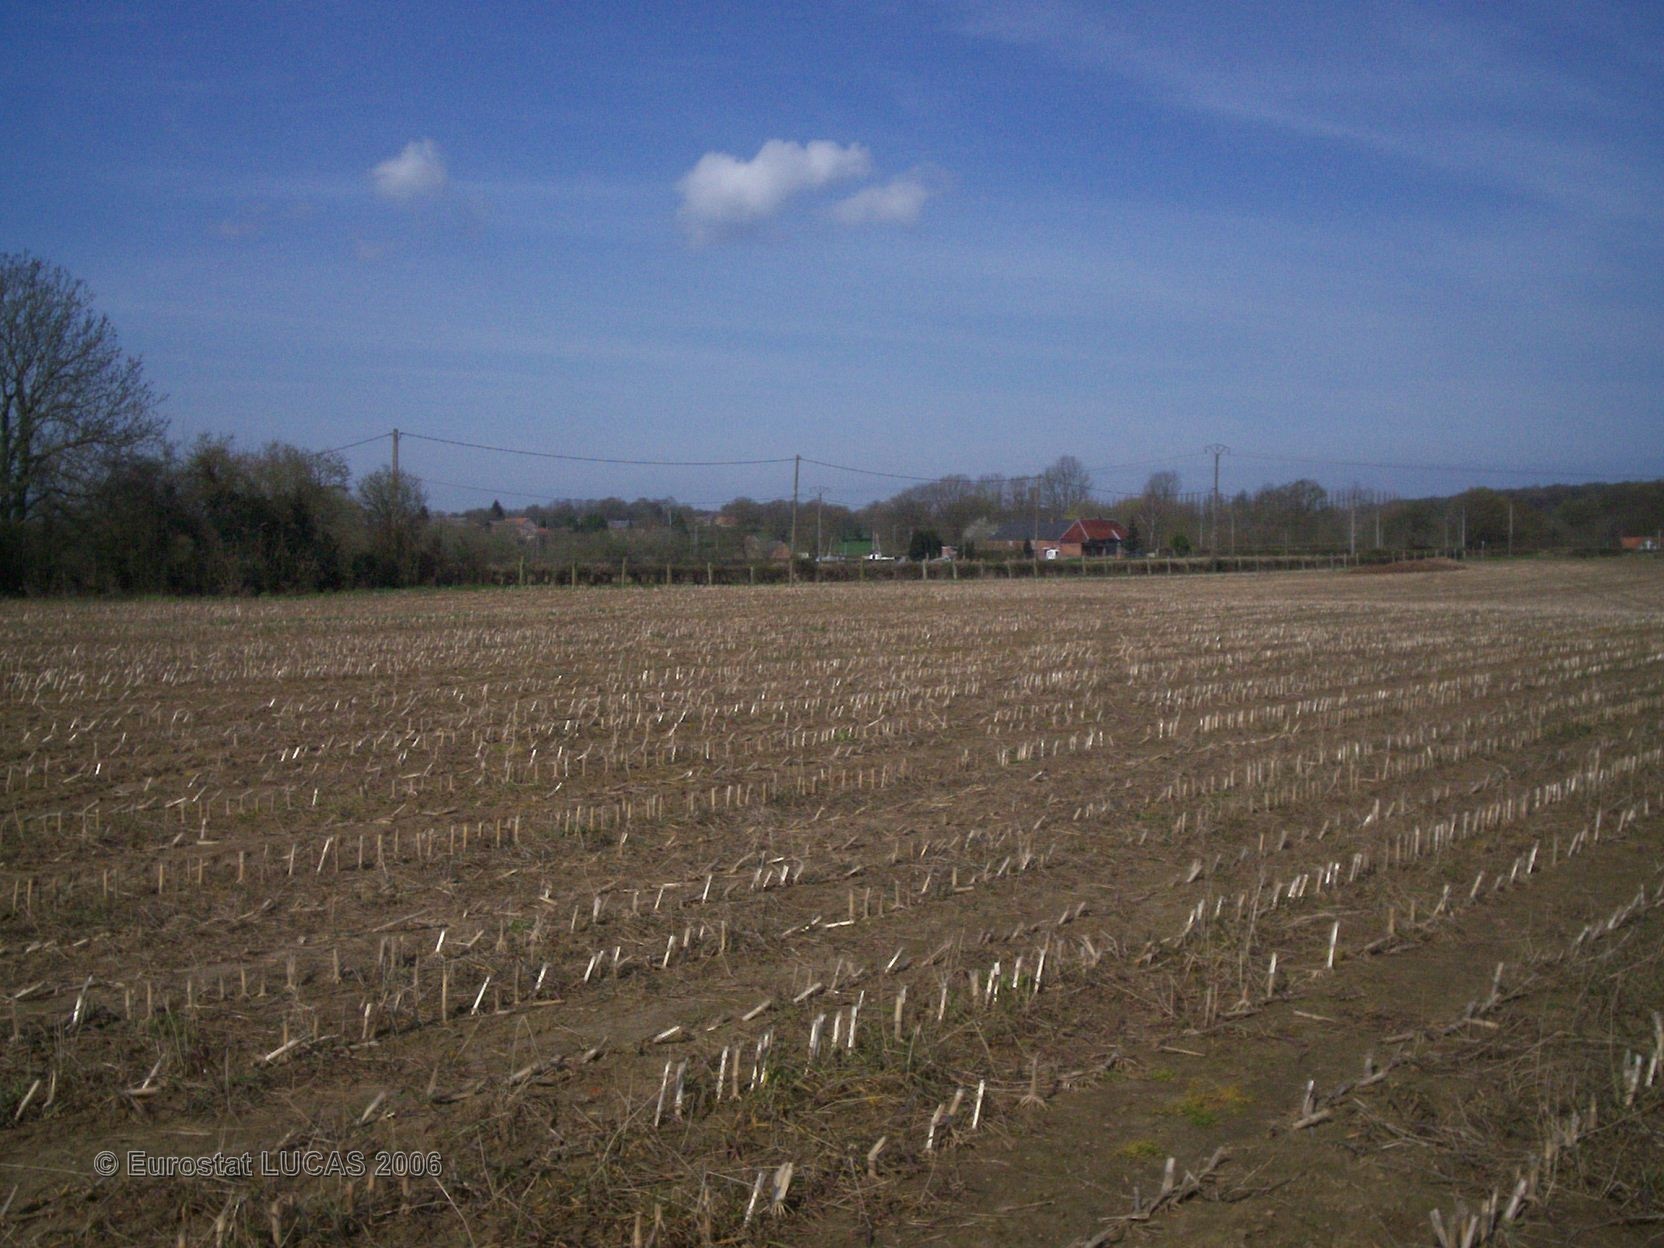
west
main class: Cropland
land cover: Maize
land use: Agriculture (excluding fallow land and kitchen gardens)
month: April
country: FR
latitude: 50.1369
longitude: 3.7113
